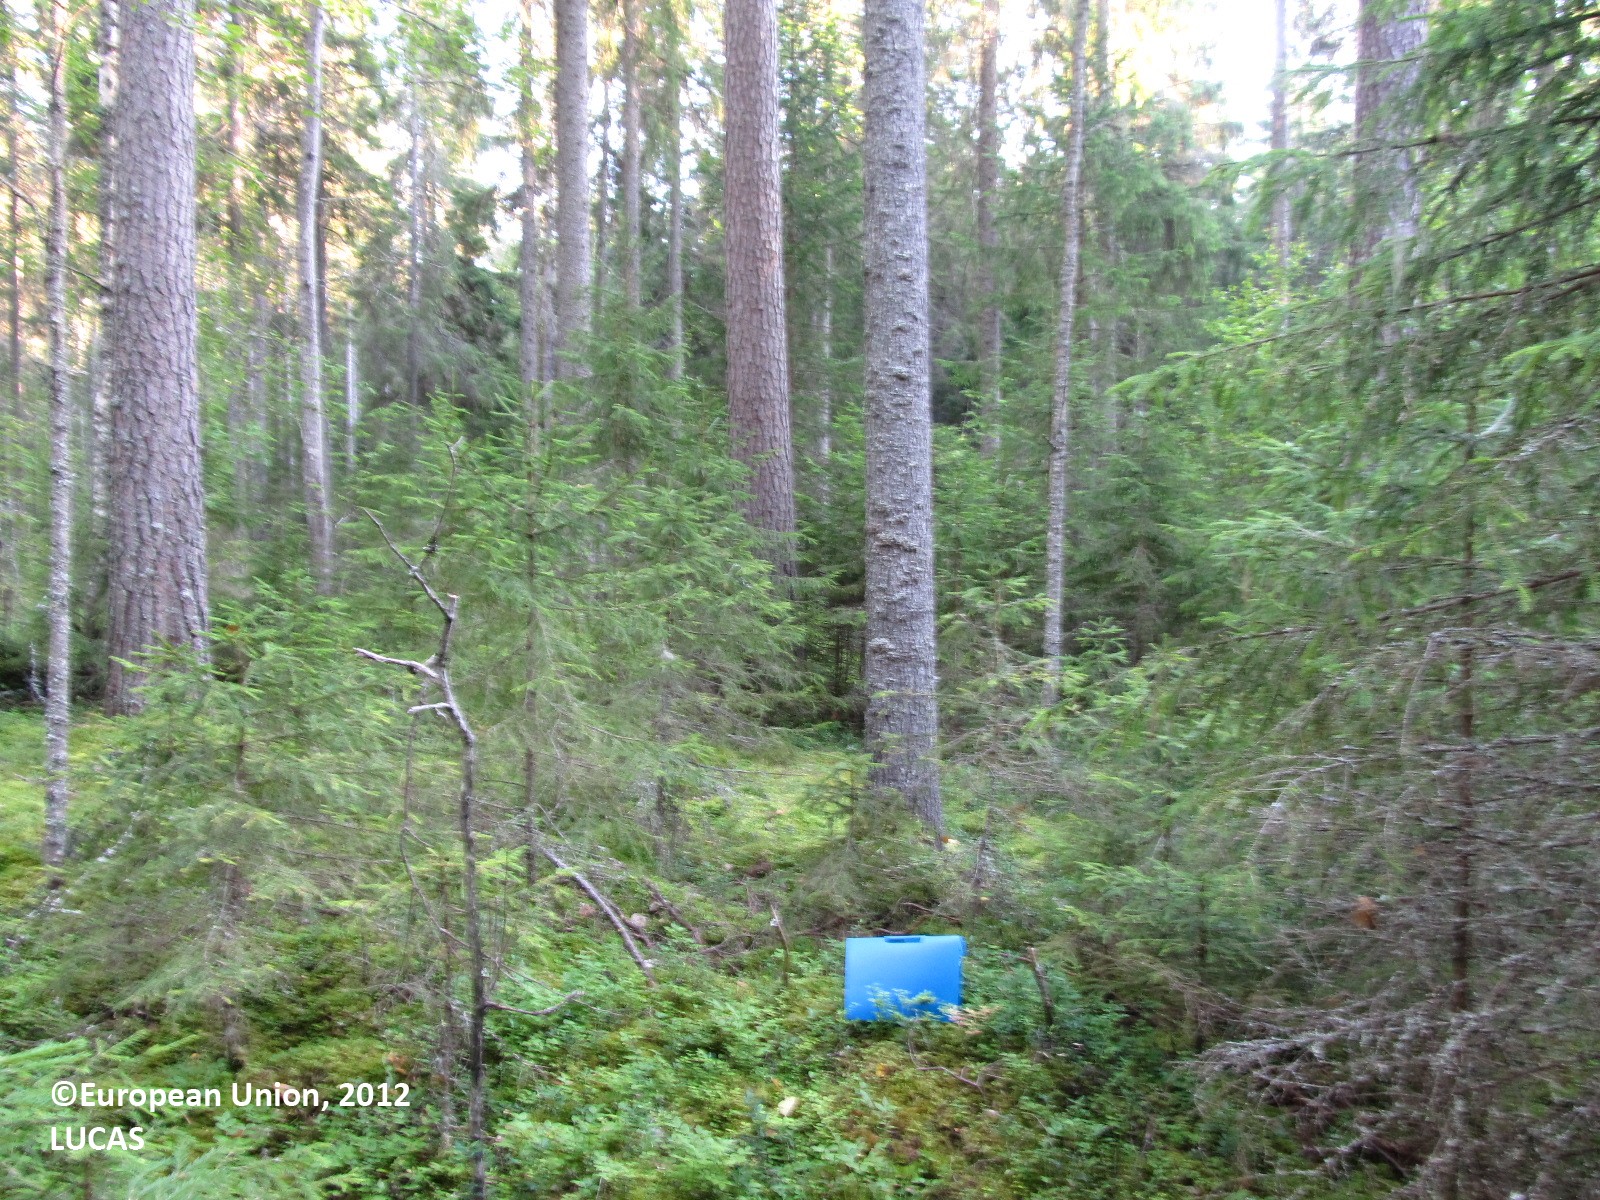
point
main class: Woodland
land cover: Other coniferous woodland
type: boreal forest
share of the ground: 50 - 75 %
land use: Forestry
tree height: > 5 m
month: August
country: FI
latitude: 62.1057
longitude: 27.7098
